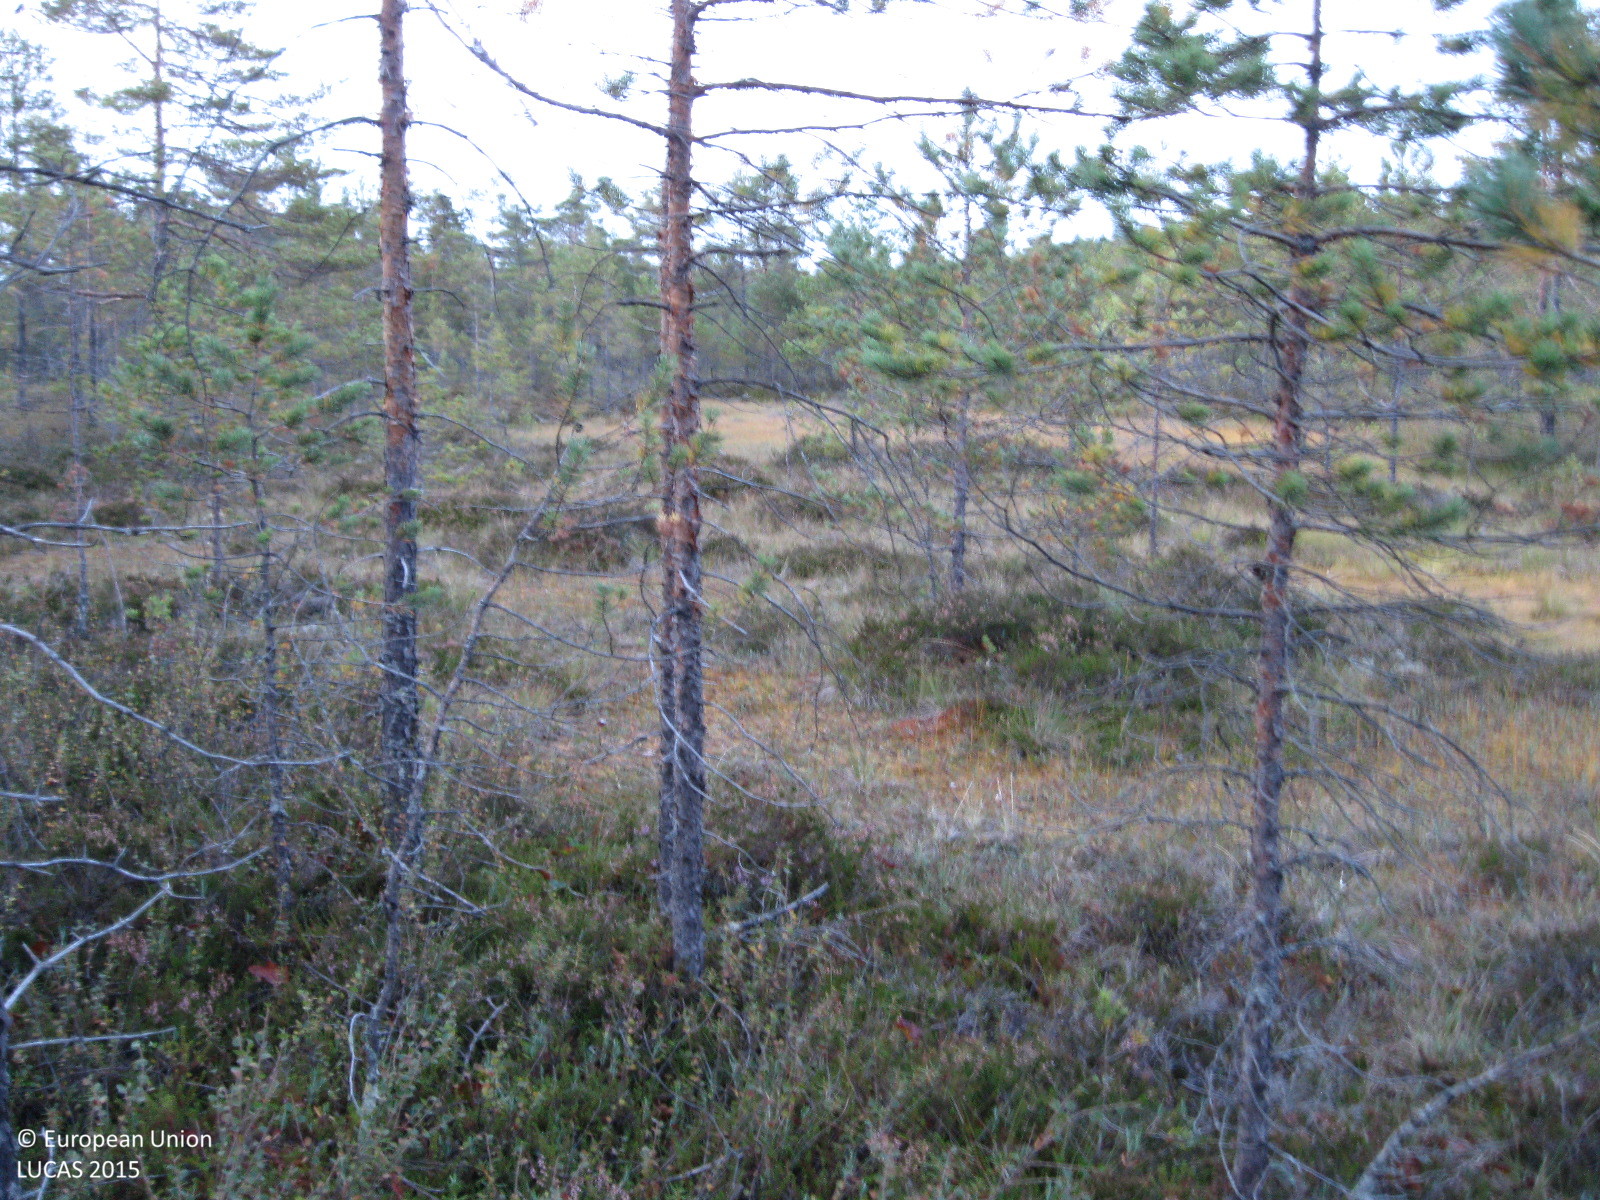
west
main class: Woodland
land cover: Pine dominated coniferous woodland
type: mire and swamp forests
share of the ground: 25 - 50 %
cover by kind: coniferous forest trees 45 %, shrubs 35 %, lichens and mosses 20 %
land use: Semi-natural and natural areas not in use
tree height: > 5 m
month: September
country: FI
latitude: 60.5906
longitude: 24.7715
